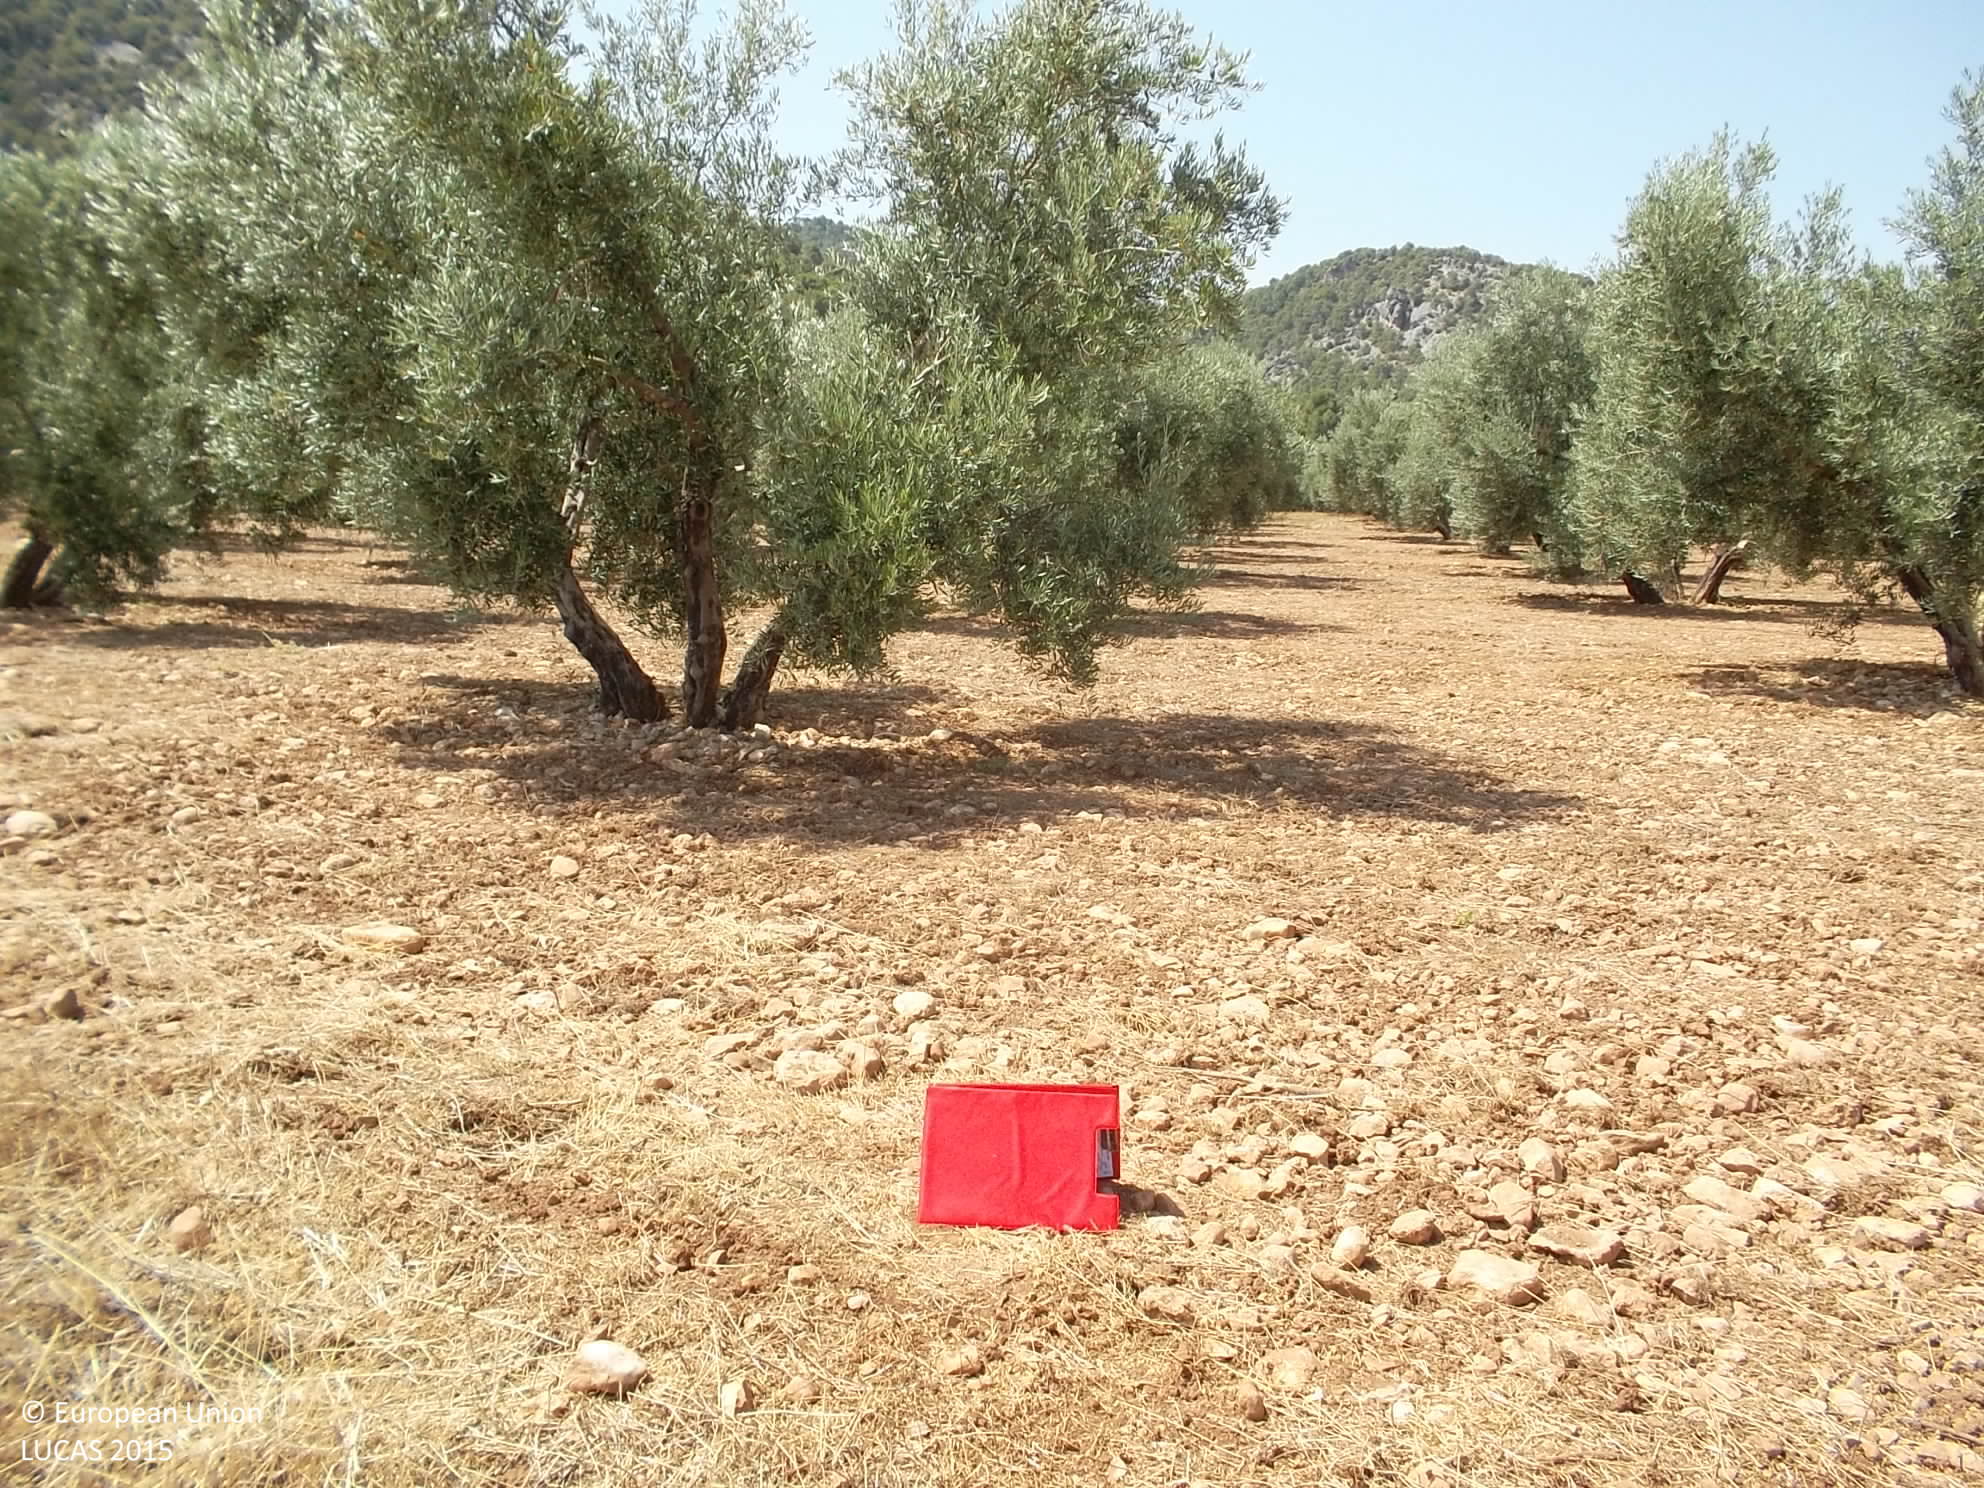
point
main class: Cropland
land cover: Olive groves
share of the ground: 25 - 50 %
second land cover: Other bare soil
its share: > 75 %
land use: Agriculture (excluding fallow land and kitchen gardens)
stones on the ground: 10 - 25 %
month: June
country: ES
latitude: 37.7606
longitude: -2.9211
